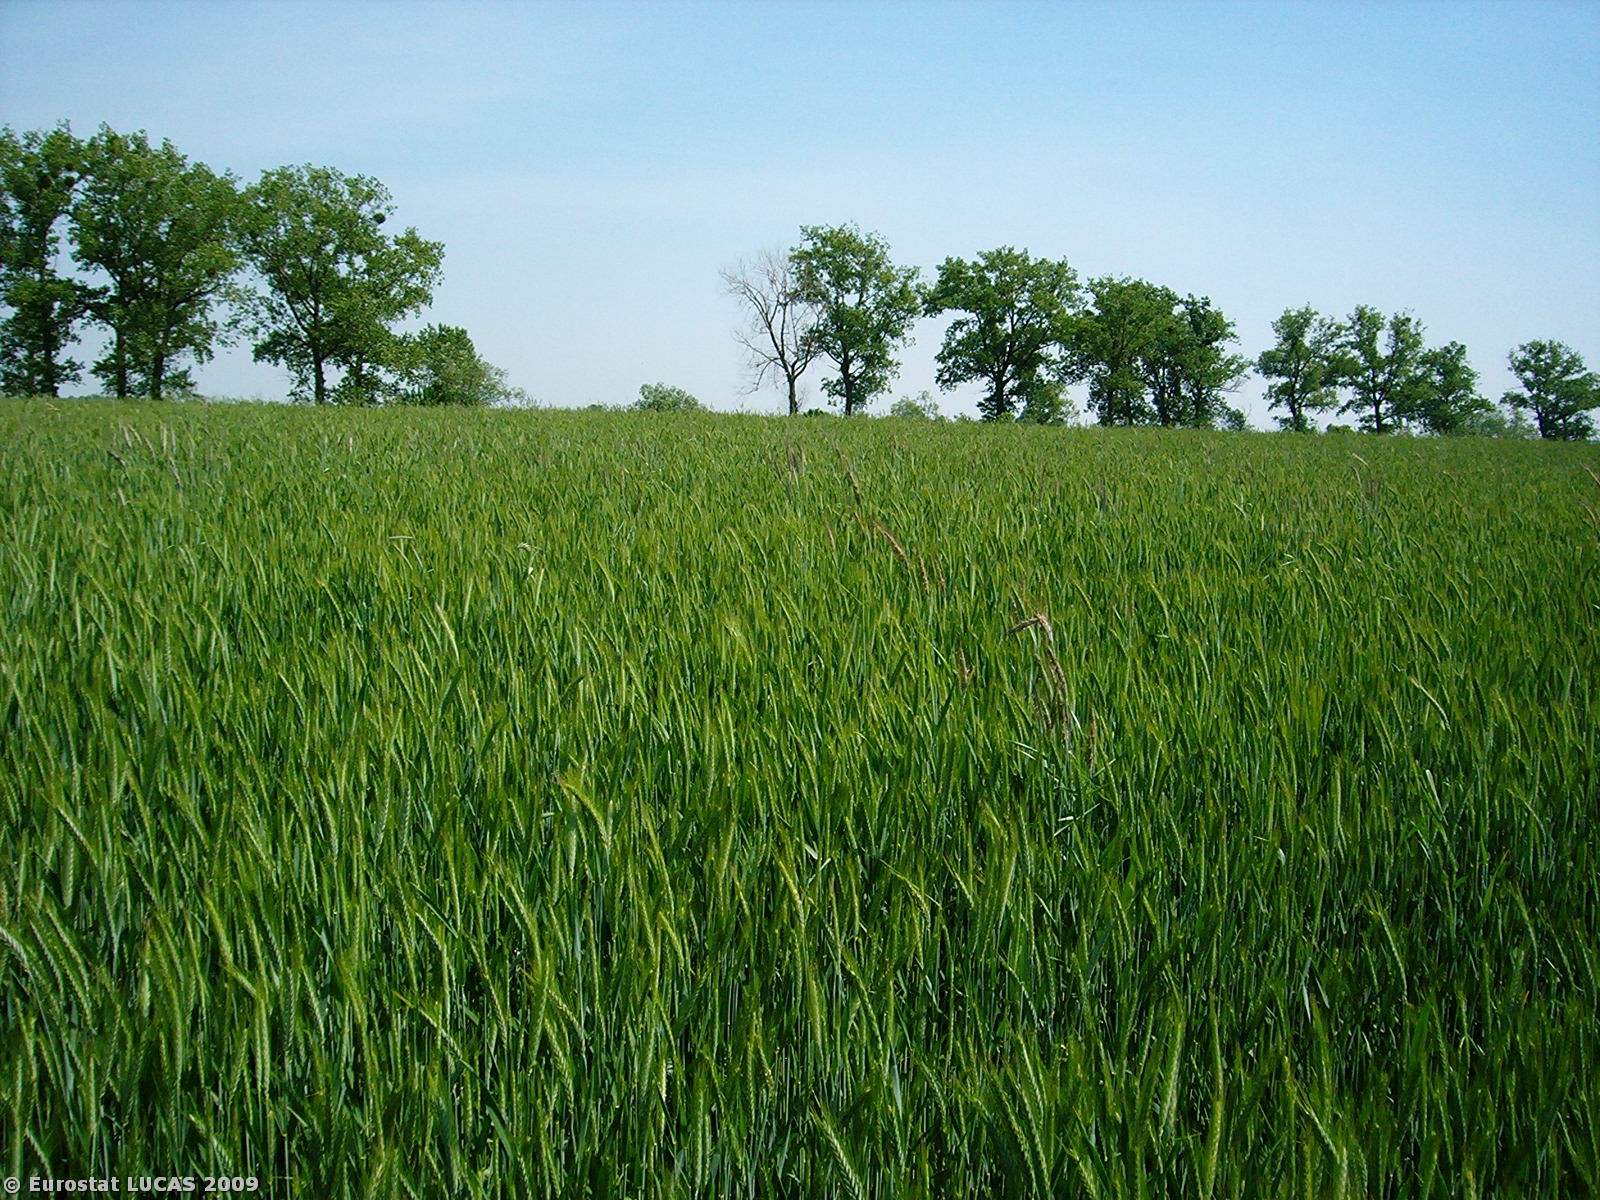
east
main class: Cropland
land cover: Rye
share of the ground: > 75 %
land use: Agriculture (excluding fallow land and kitchen gardens)
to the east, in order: Rye; Grass margins; Abandoned hedges; Grass margins; Paved roads, cycling and walking lanes; Grass margins; Abandoned hedges; Grass margins; Common wheat; Triticale
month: May
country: PL
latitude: 52.5299
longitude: 16.3898
